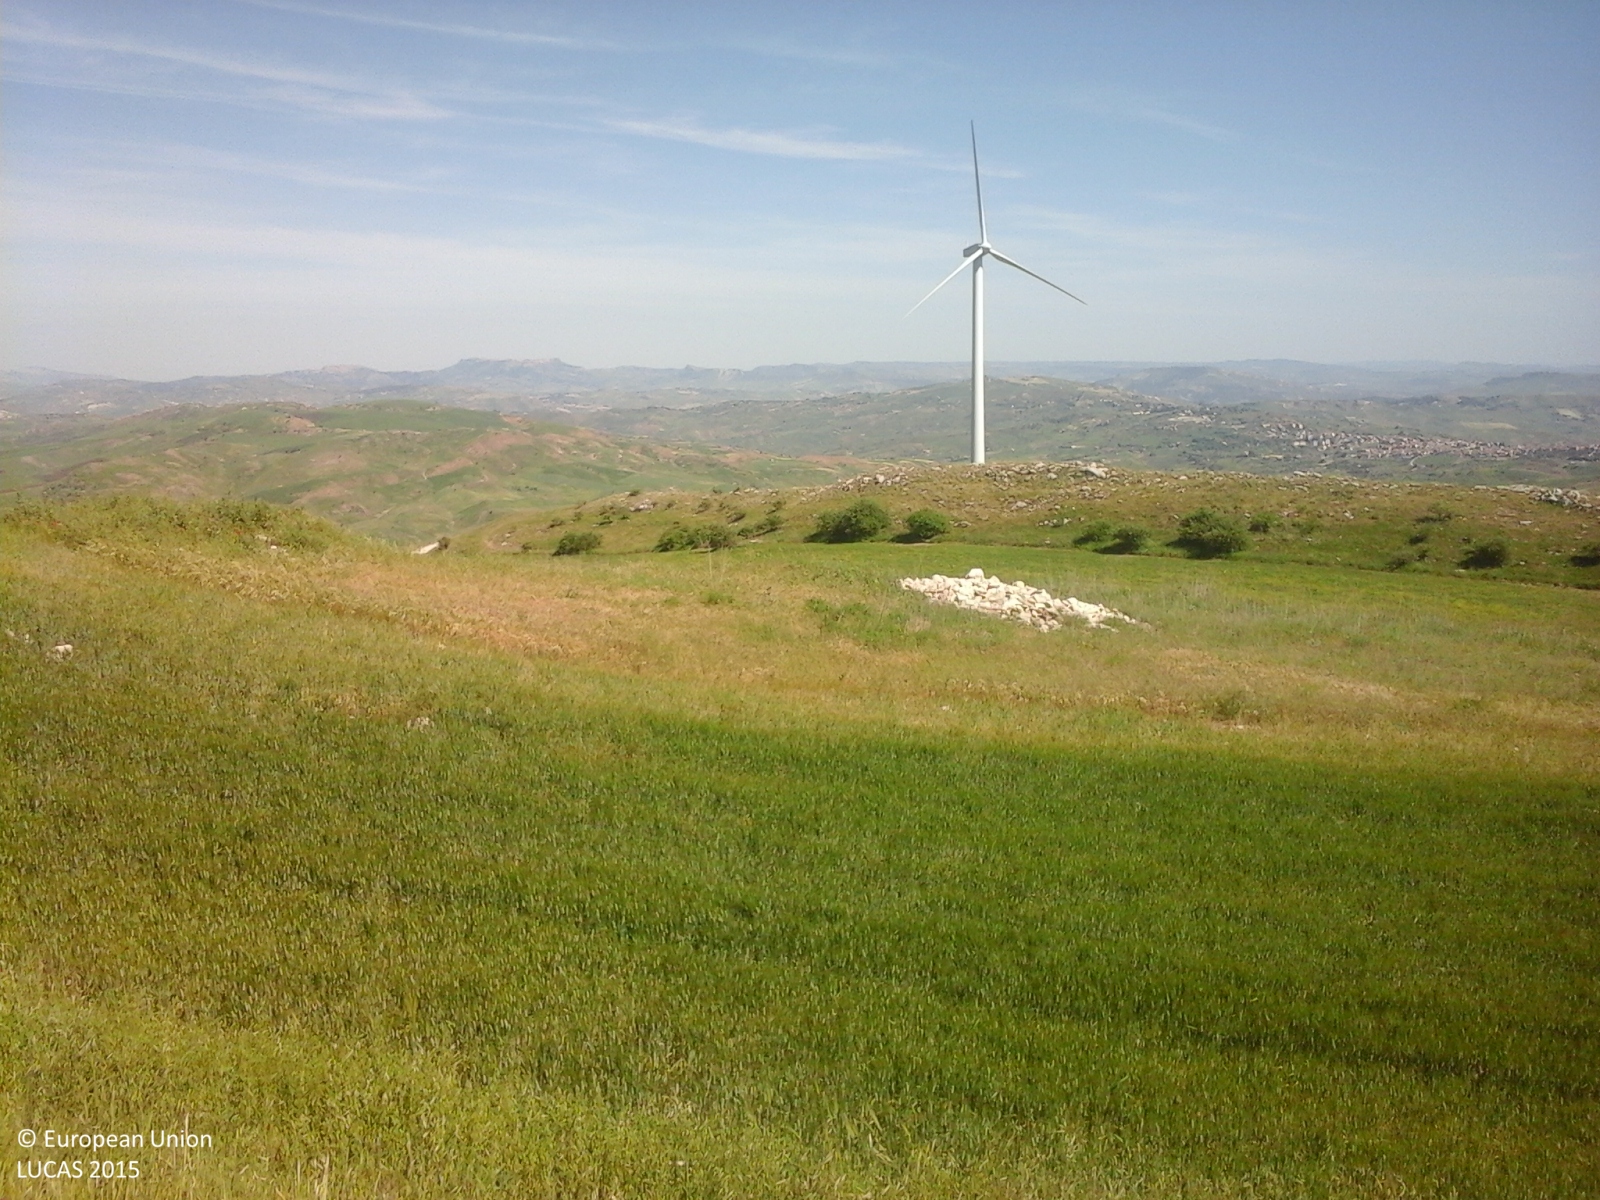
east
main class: Cropland
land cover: Durum wheat
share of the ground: > 75 %
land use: Agriculture (excluding fallow land and kitchen gardens)
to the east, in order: Durum wheat; Grassland without tree/shrub cover; Rocks and stones; Grassland without tree/shrub cover; Durum wheat; Grass margins; Tracks; Grassland without tree/shrub cover; Tracks; Grass margins; Temporary grasslands
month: May
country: IT
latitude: 37.6273
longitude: 13.9931
